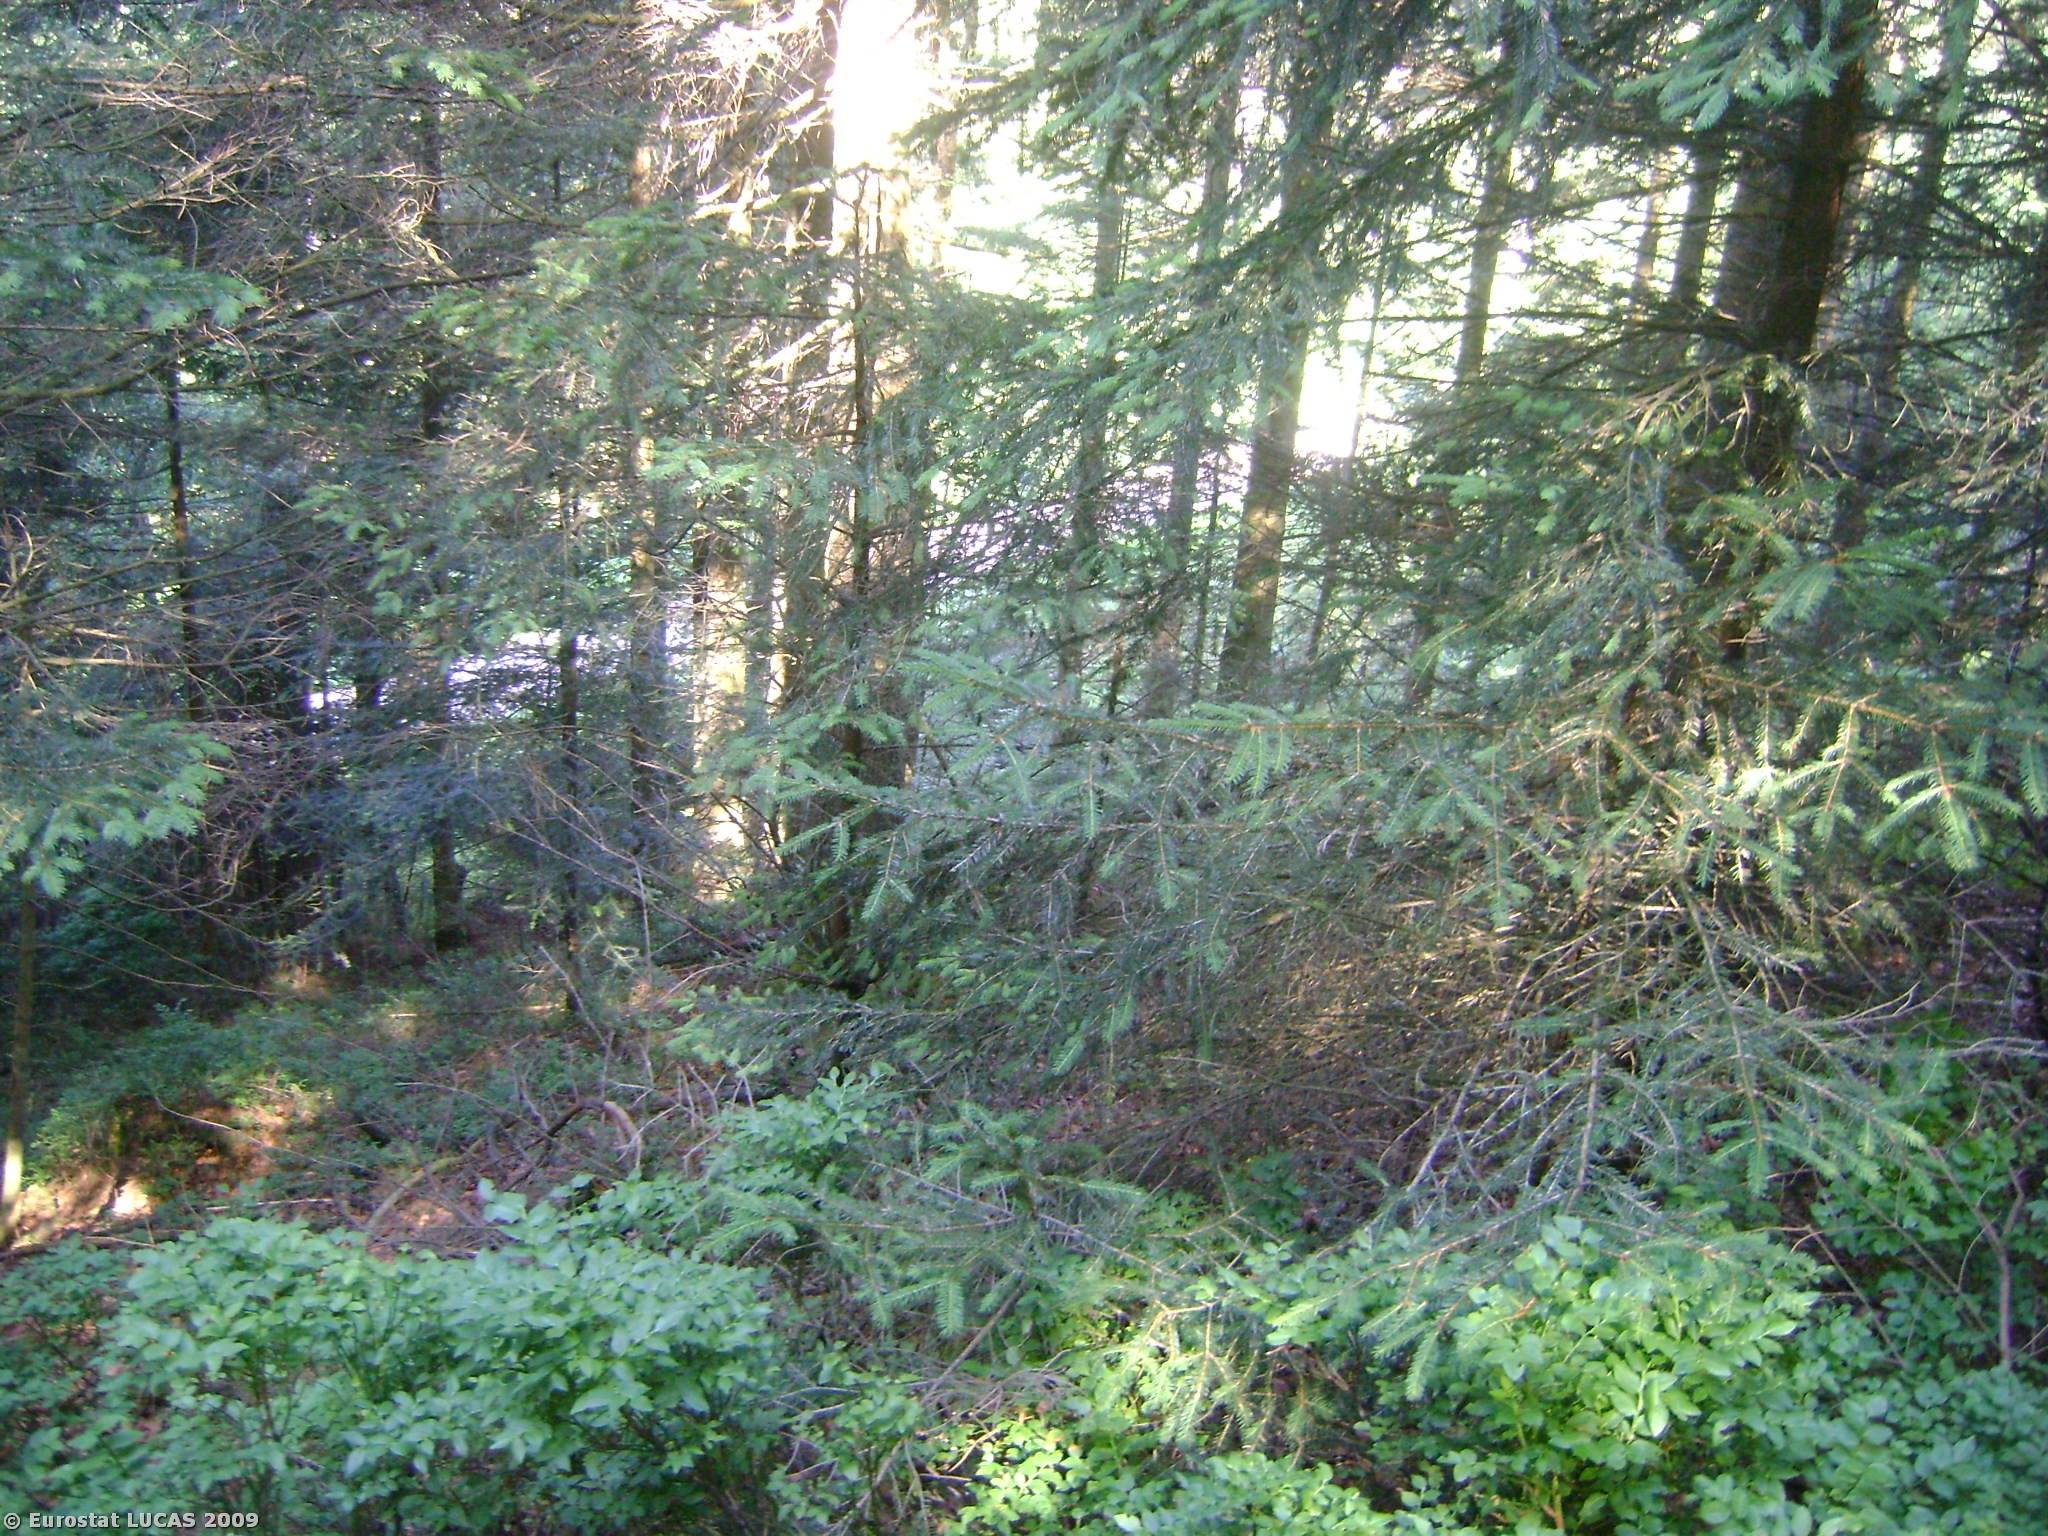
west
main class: Woodland
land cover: Coniferous woodland
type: hemiboreal forest and nemoral coniferous forest and mixed broadleaved-coniferous forest
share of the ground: > 75 %
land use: Forestry
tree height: > 5 m
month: June
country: AT
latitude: 48.0314
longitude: 13.2577
